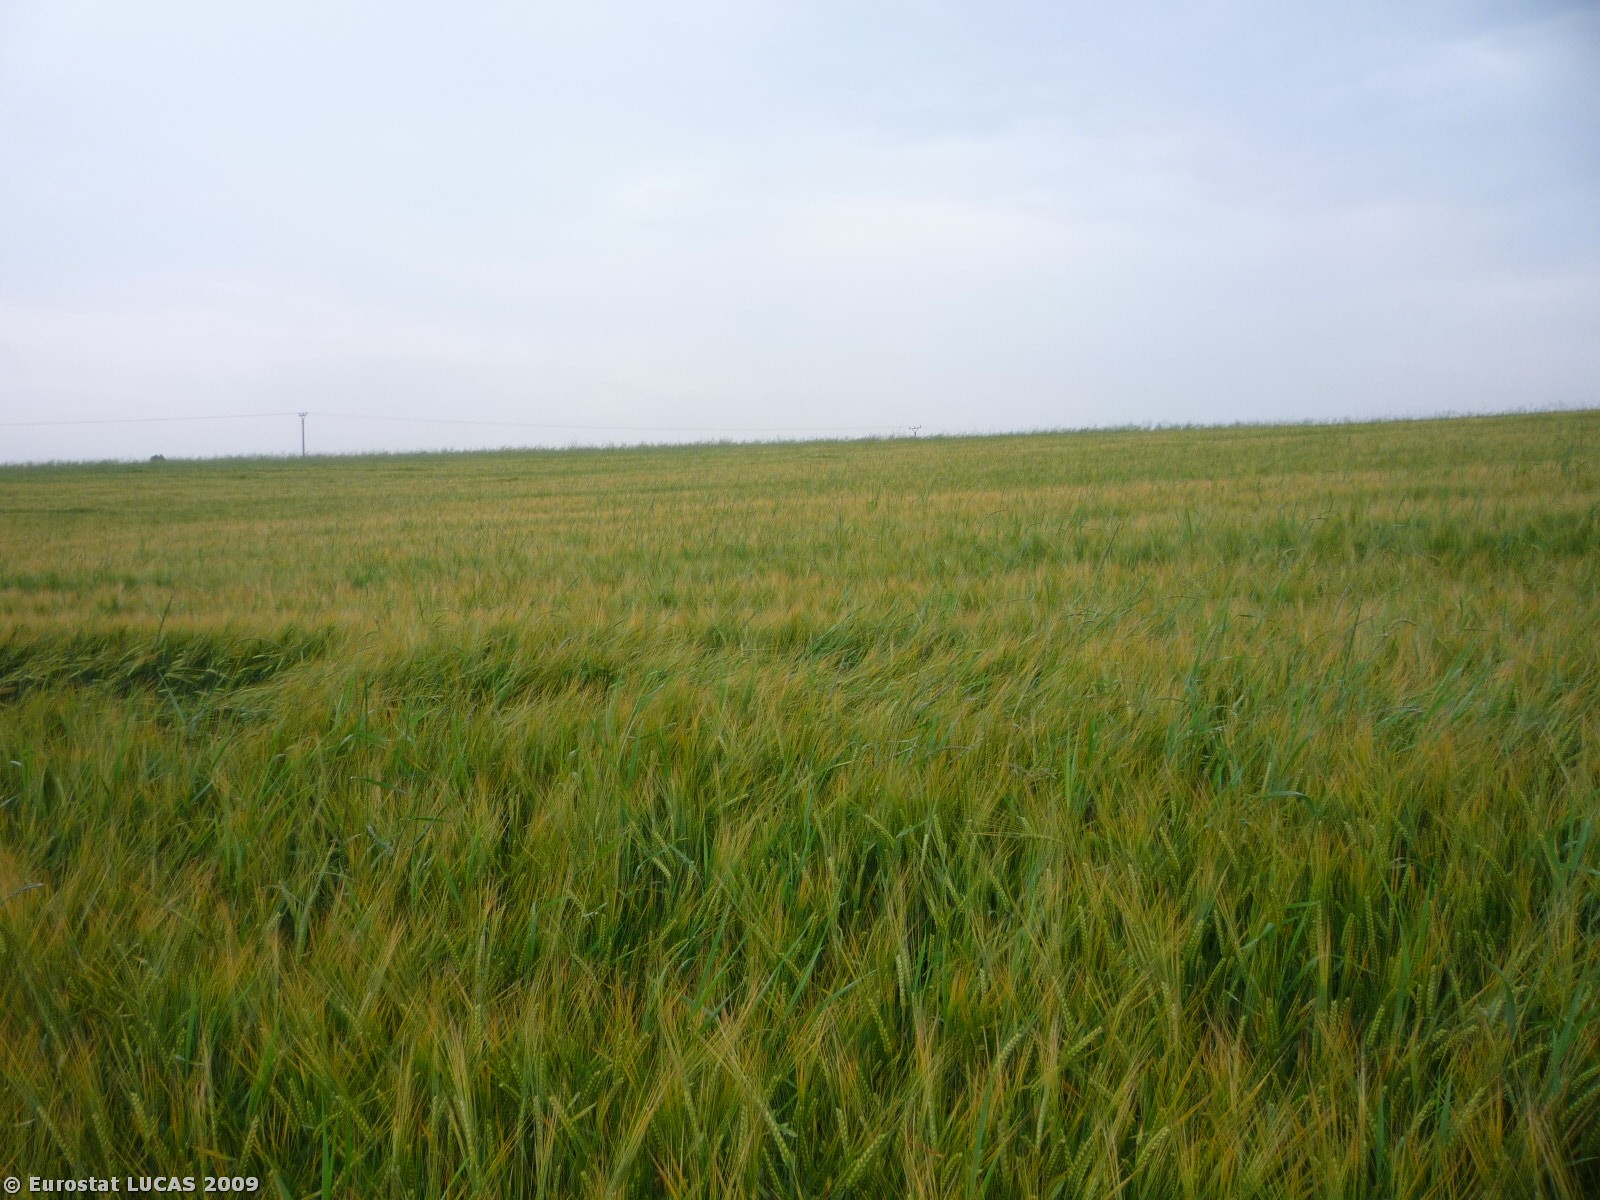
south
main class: Cropland
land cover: Barley
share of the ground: > 75 %
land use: Agriculture (excluding fallow land and kitchen gardens)
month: July
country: CZ
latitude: 50.0248
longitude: 14.9019
